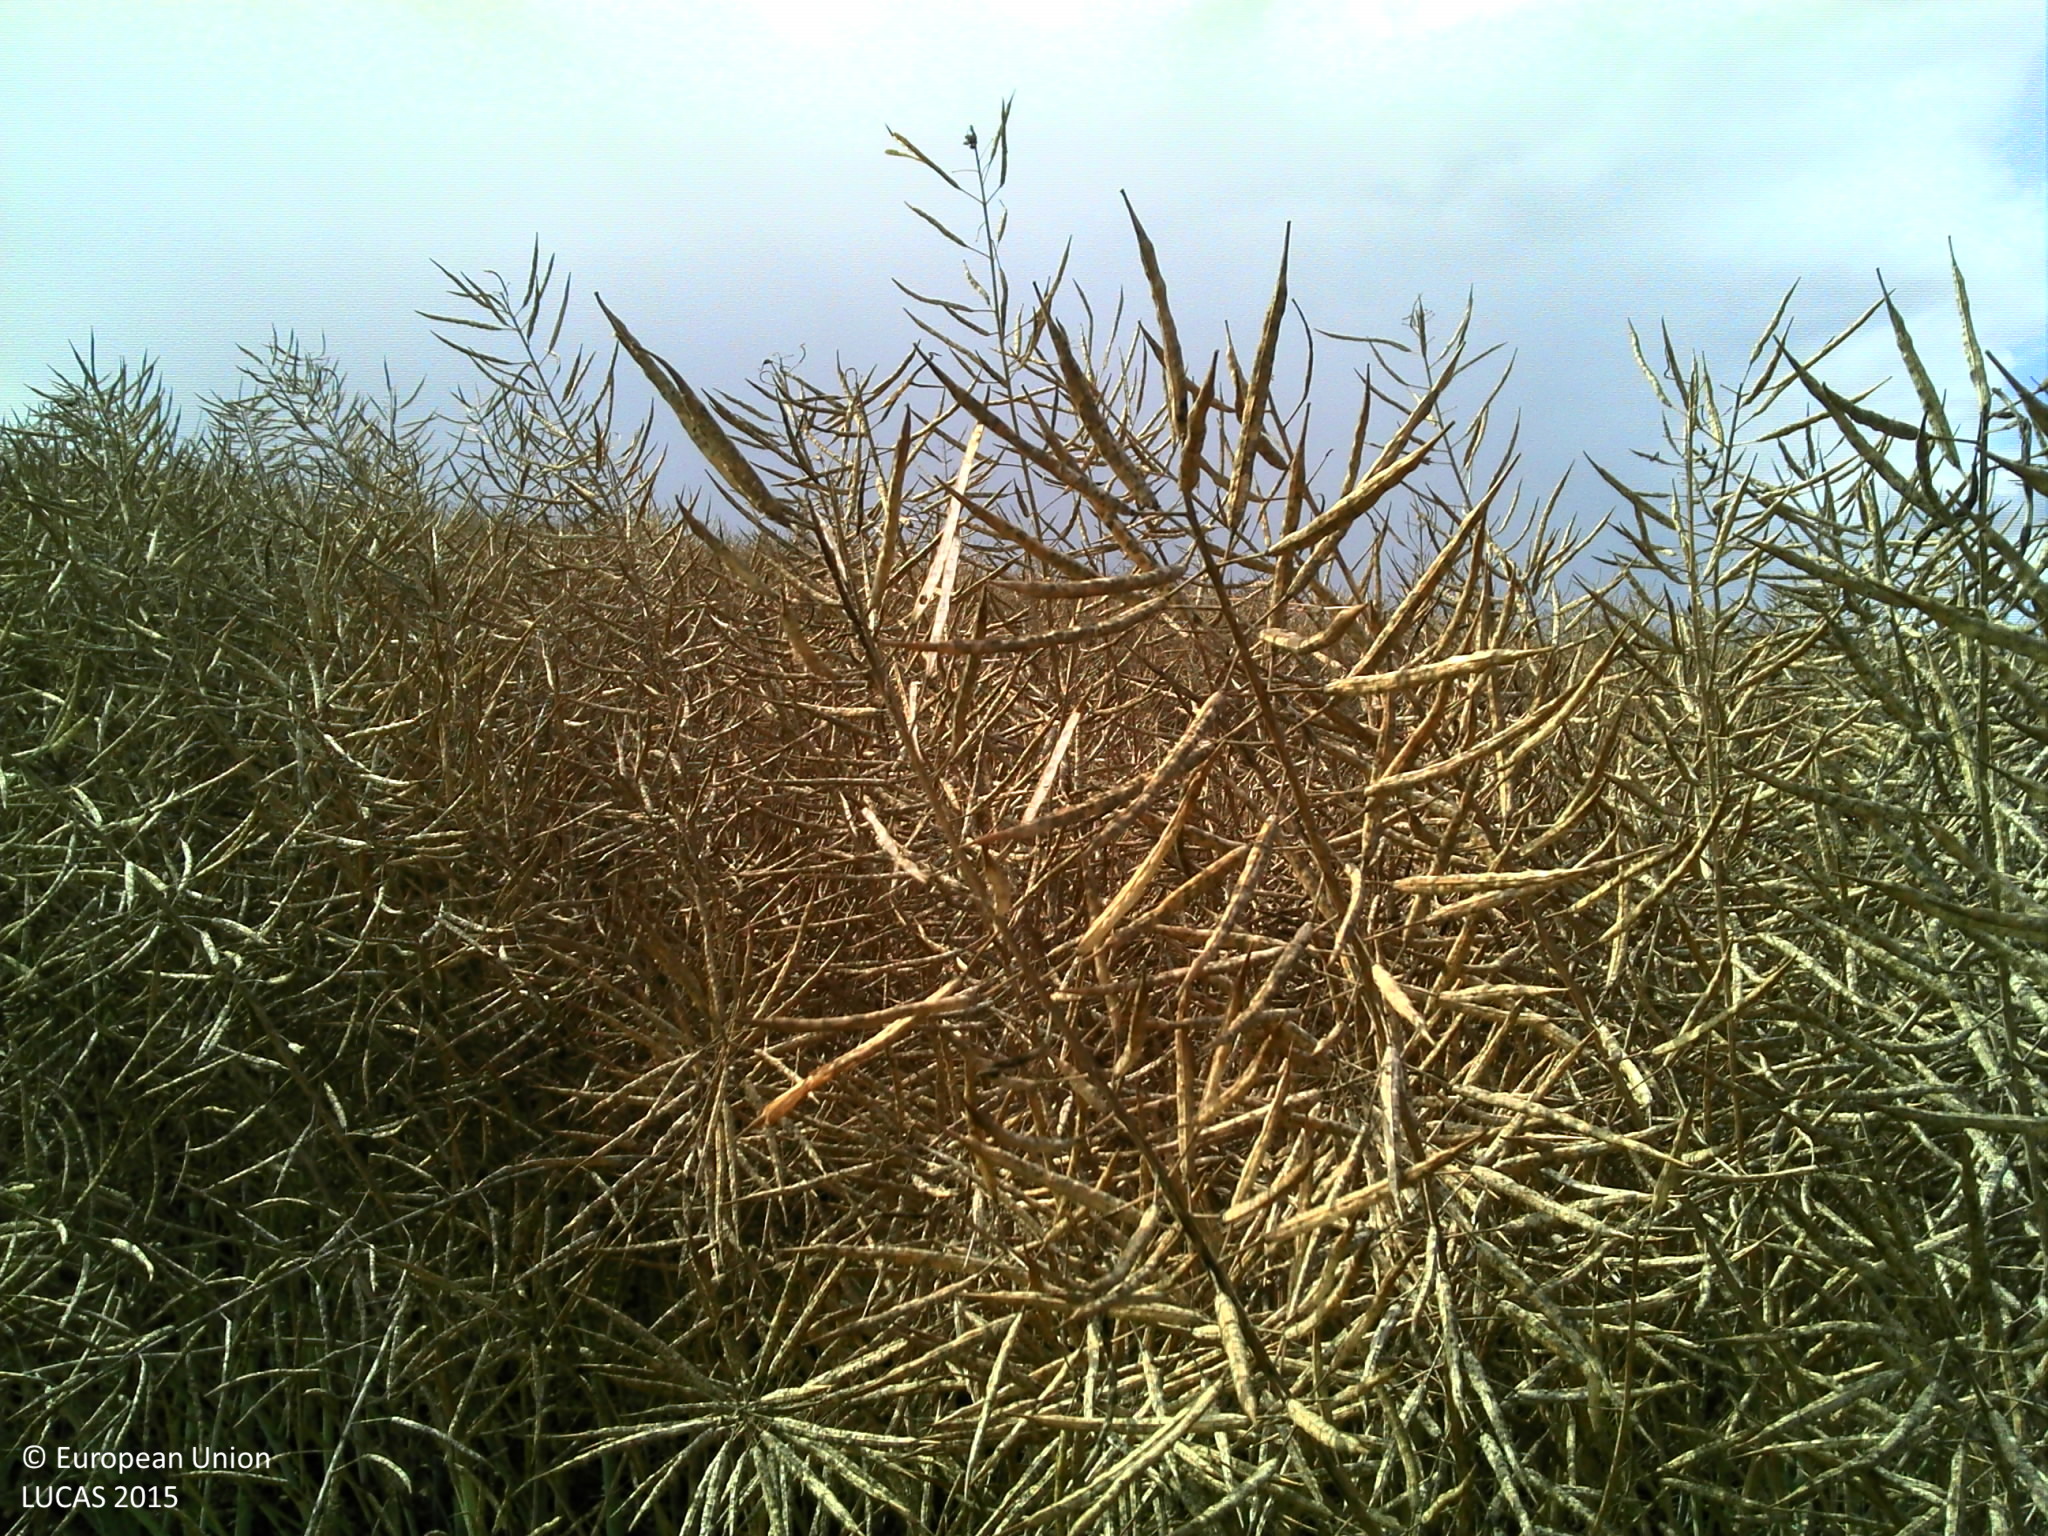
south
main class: Cropland
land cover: Rape and turnip rape
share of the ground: > 75 %
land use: Agriculture (excluding fallow land and kitchen gardens)
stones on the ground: 25 - 50 %
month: July
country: FR
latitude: 50.0286
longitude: 2.5194
